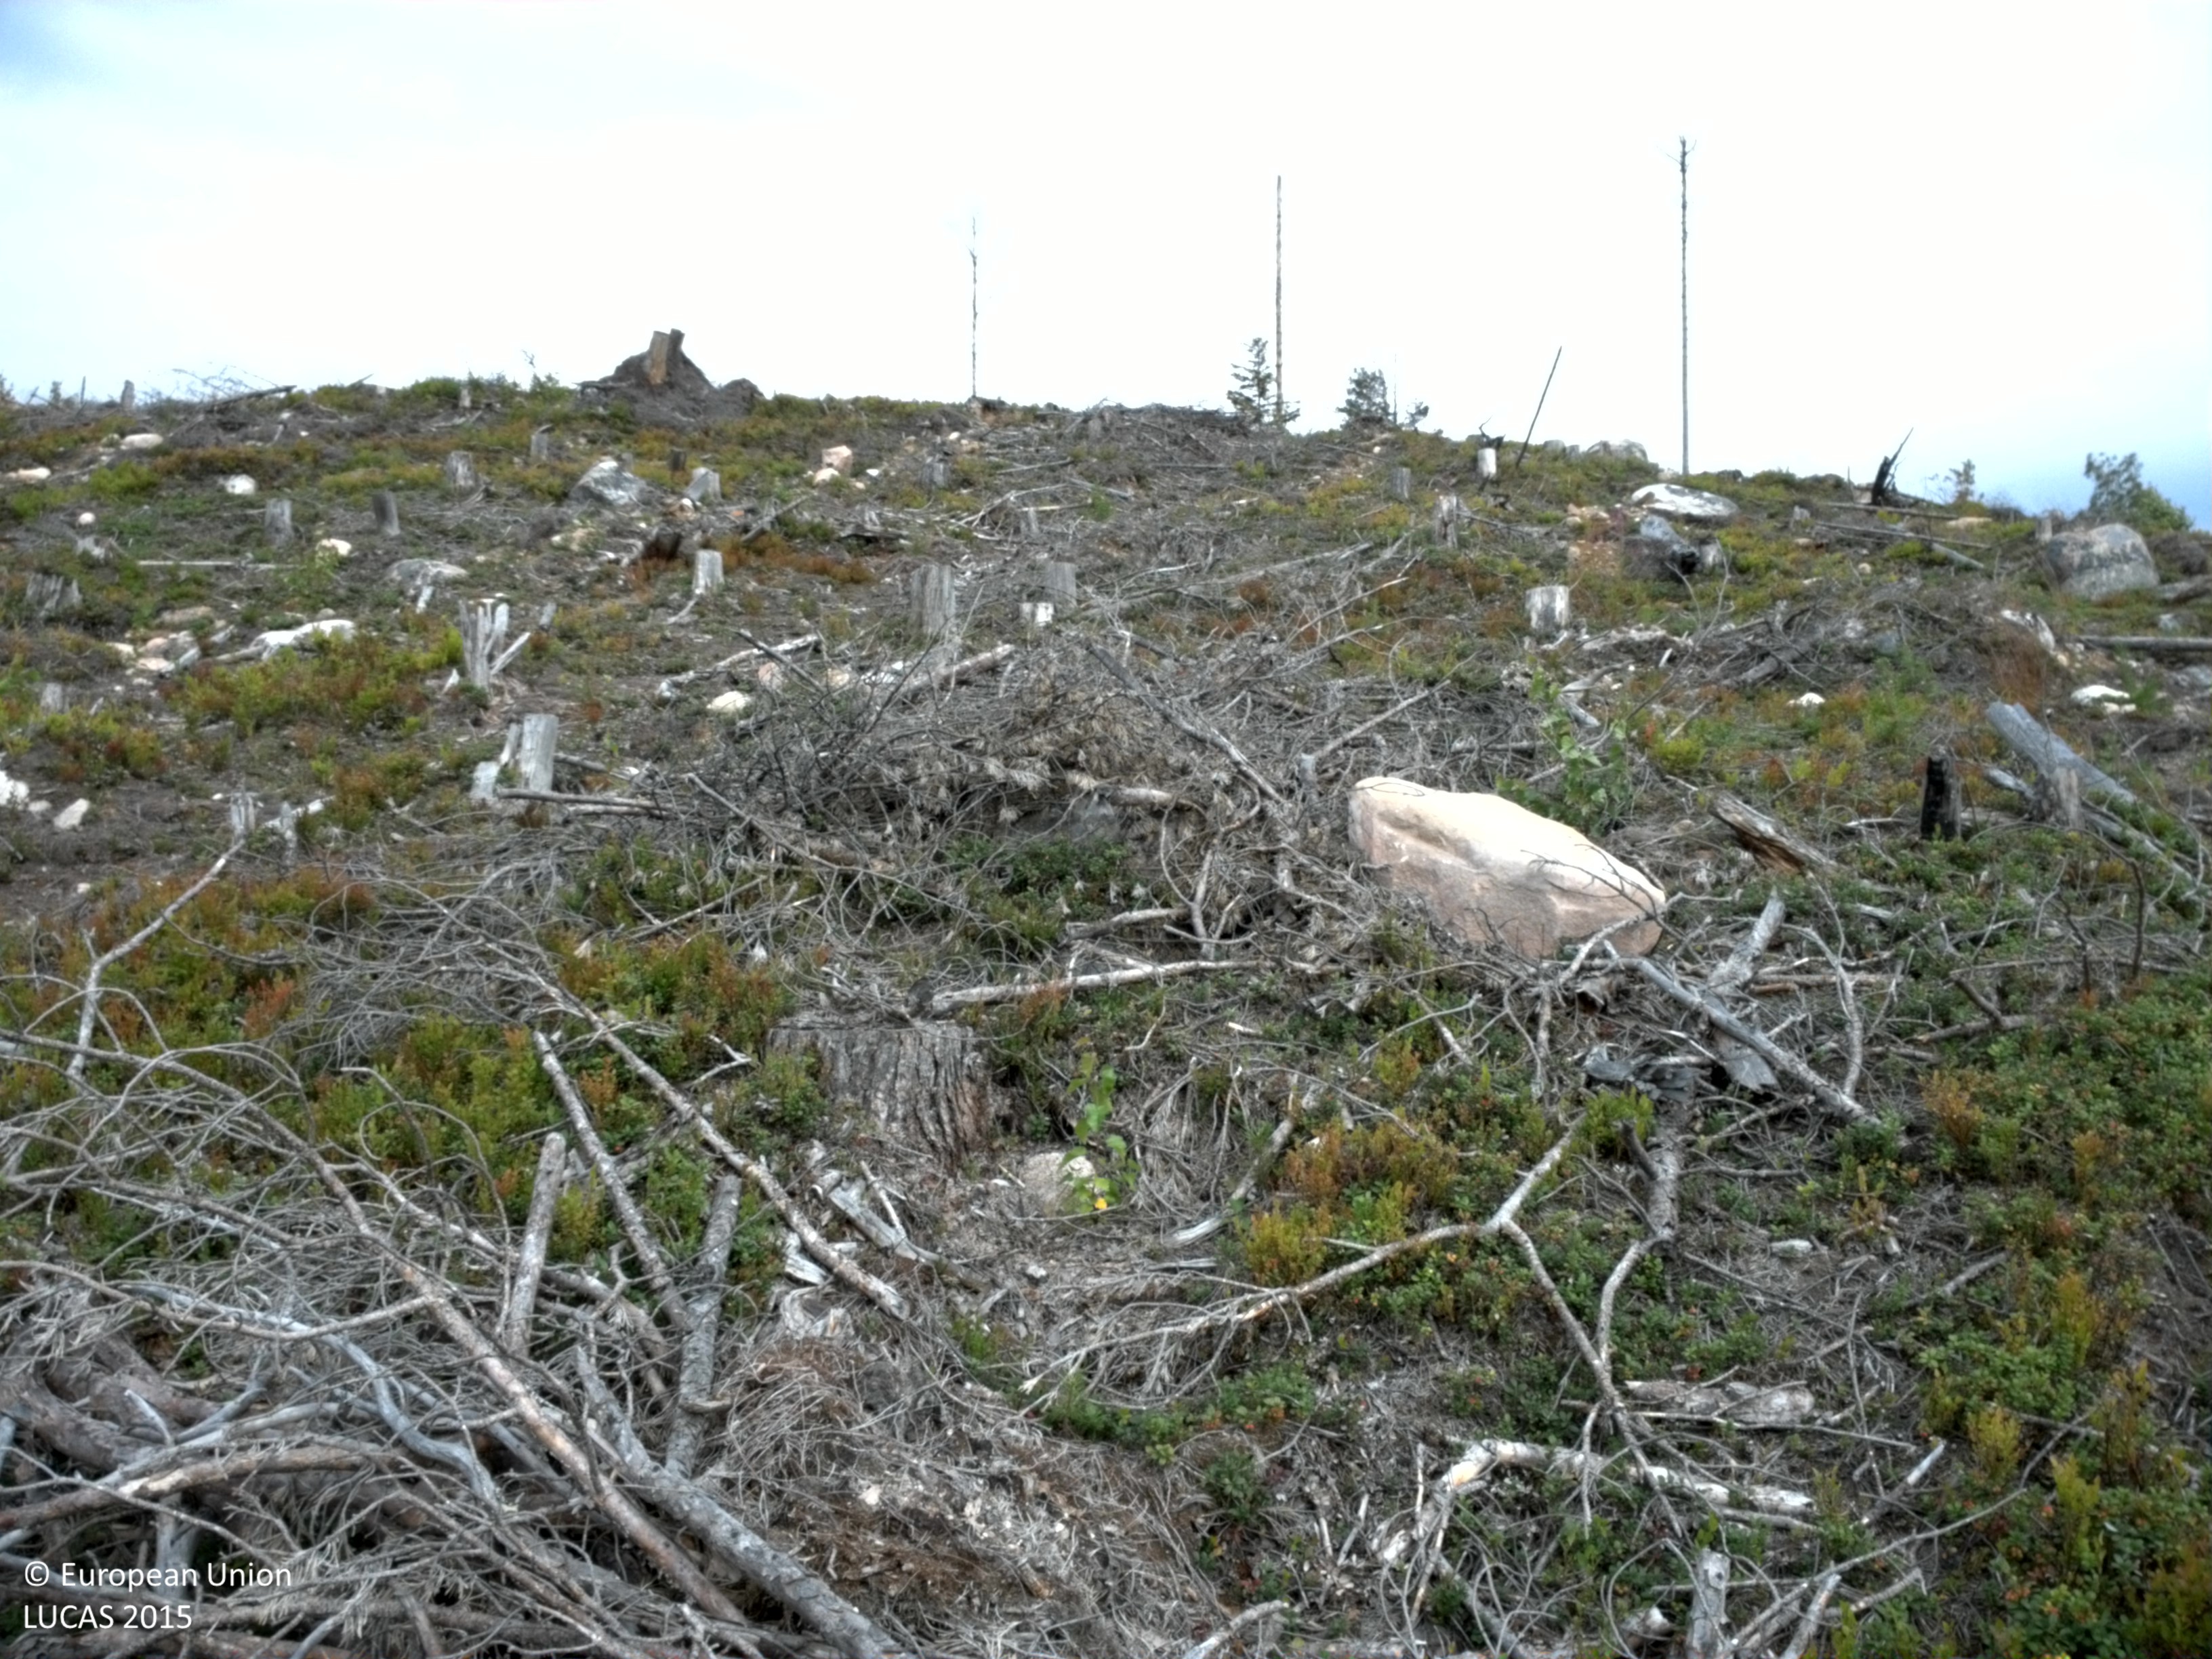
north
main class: Shrubland
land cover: Shrubland with sparse tree cover
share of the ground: > 75 %
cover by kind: shrubs 80 %, broadleaved forest trees 5 %, lichens and mosses 5 %, consolidated bare surface 5 %, unconsolidated bare surface 5 %
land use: Forestry
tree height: < 5 m
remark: Clear cut
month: August
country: SE
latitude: 66.3137
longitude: 20.5098
